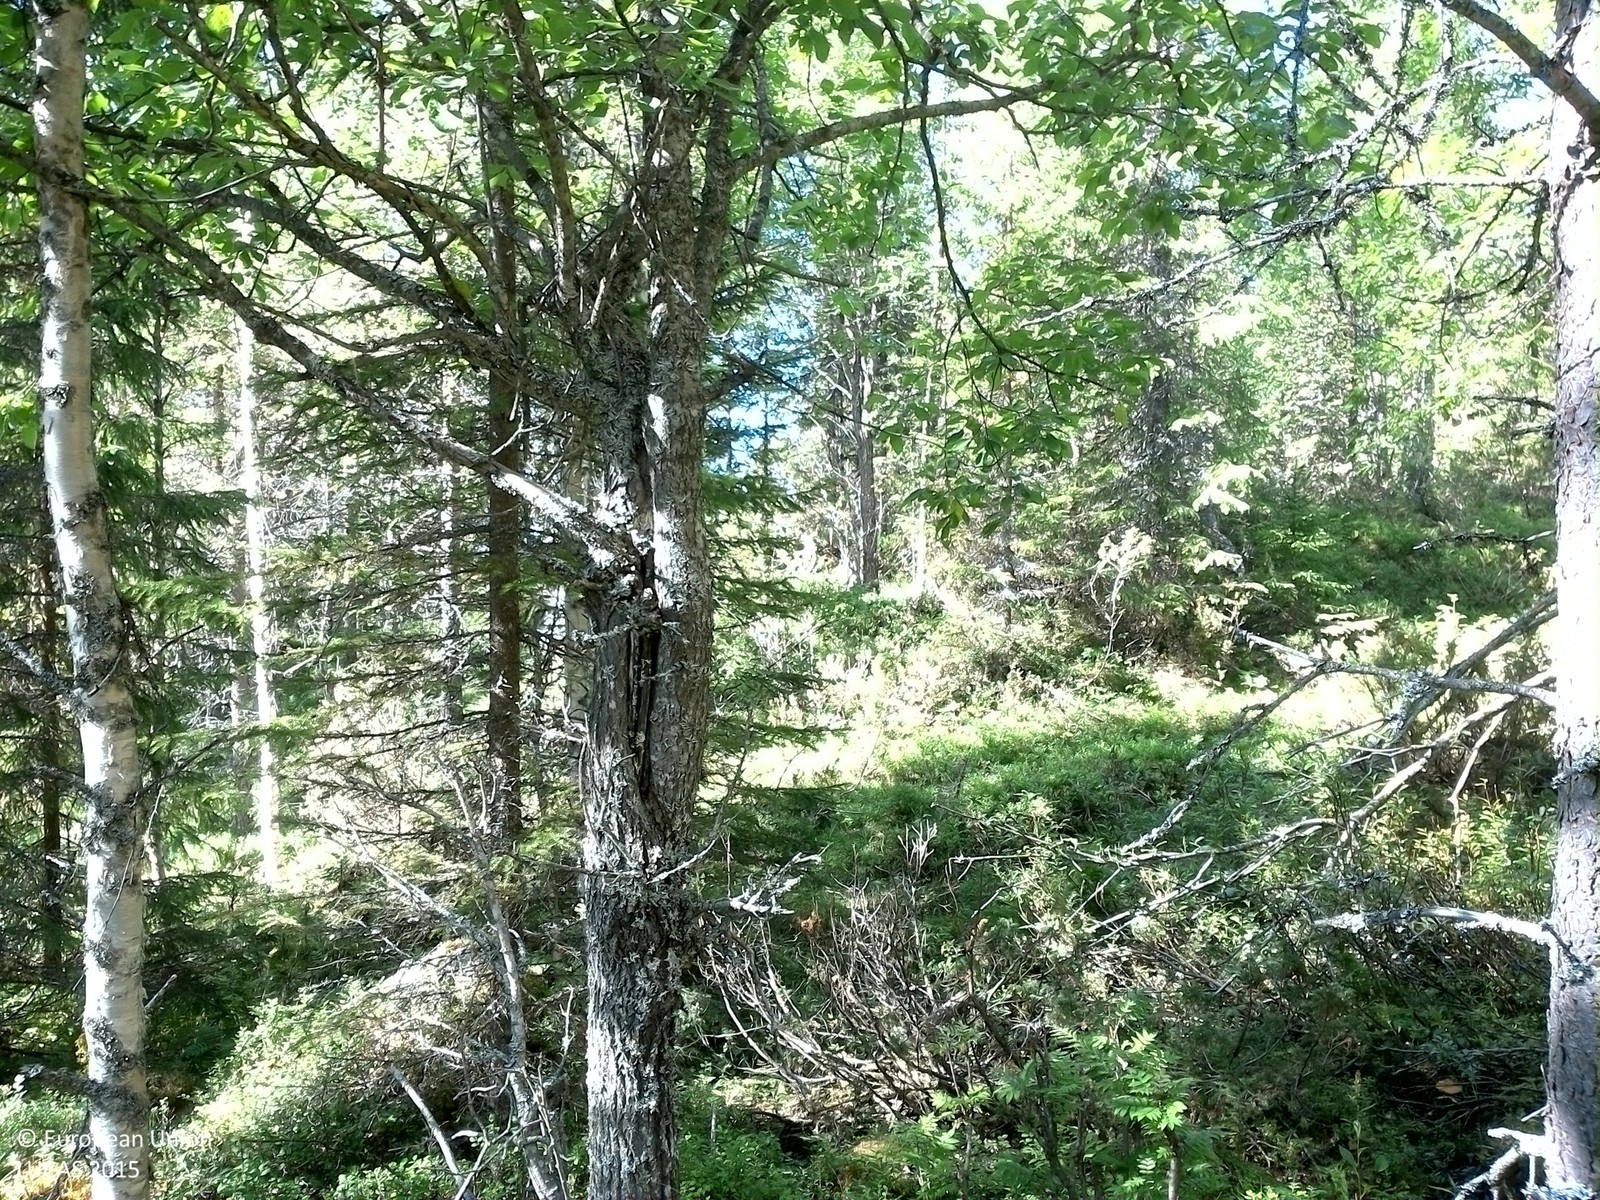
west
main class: Woodland
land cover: Pine dominated mixed woodland
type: boreal forest
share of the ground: 50 - 75 %
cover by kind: coniferous forest trees 35 %, shrubs 35 %, broadleaved forest trees 30 %
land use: Forestry
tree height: > 5 m
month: August
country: SE
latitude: 63.9068
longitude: 17.6131
